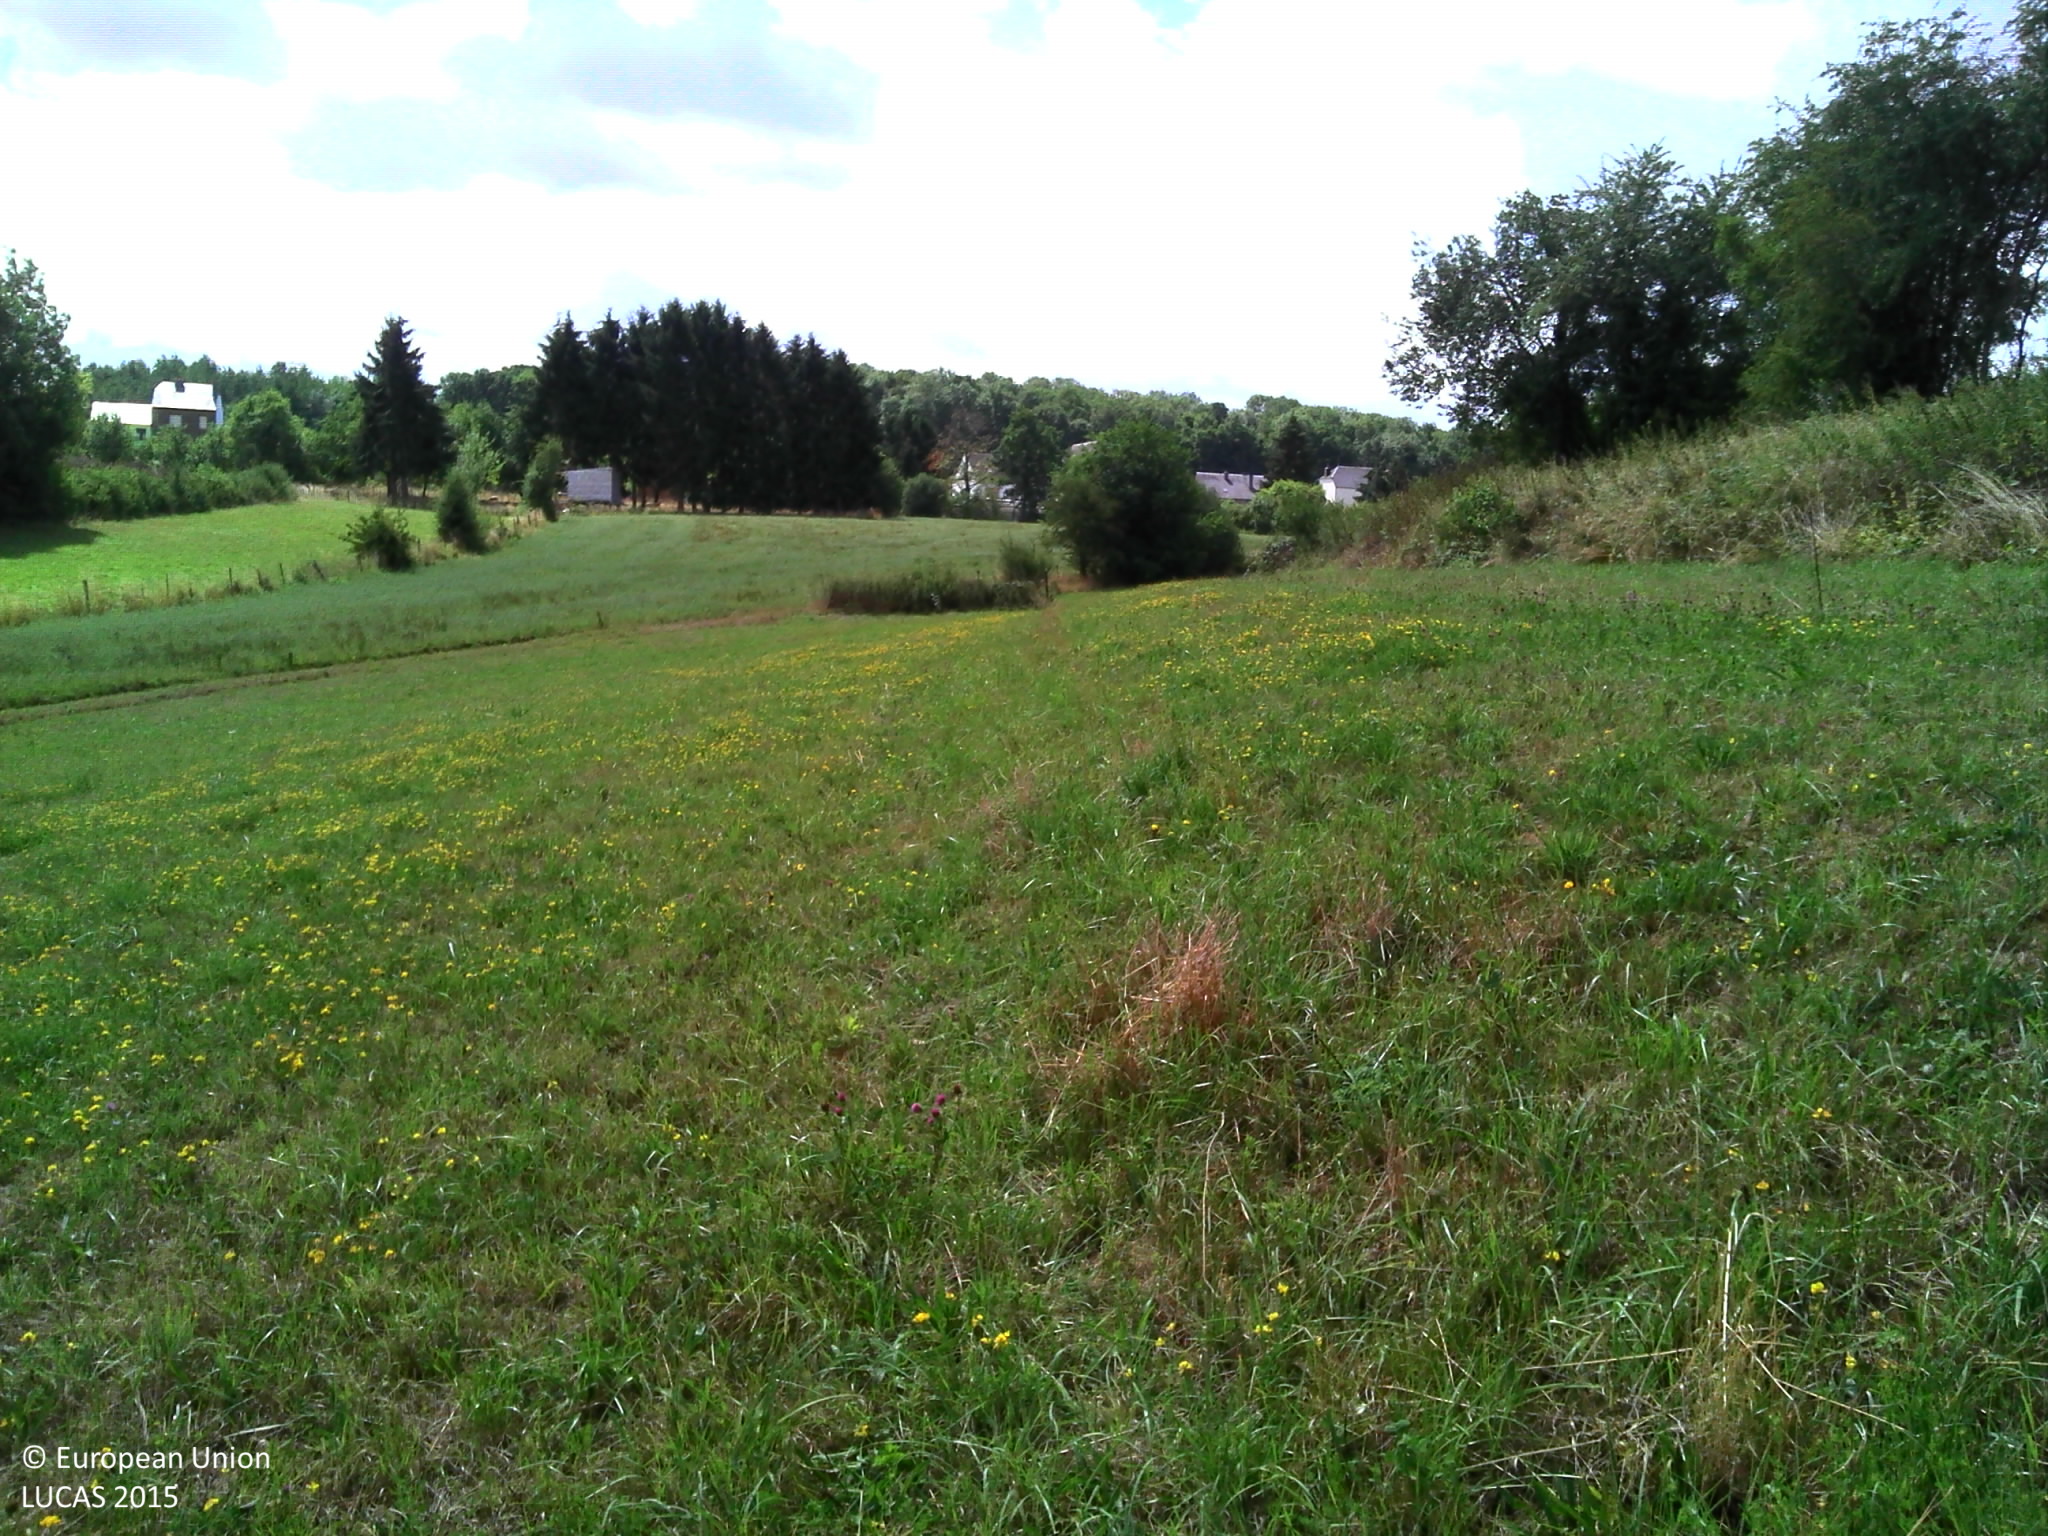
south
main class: Grassland
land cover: Grassland without tree/shrub cover
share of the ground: > 75 %
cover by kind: herbaceous plants 100 %
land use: Agriculture (excluding fallow land and kitchen gardens)
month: July
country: BE
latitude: 49.5650
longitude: 5.7542
